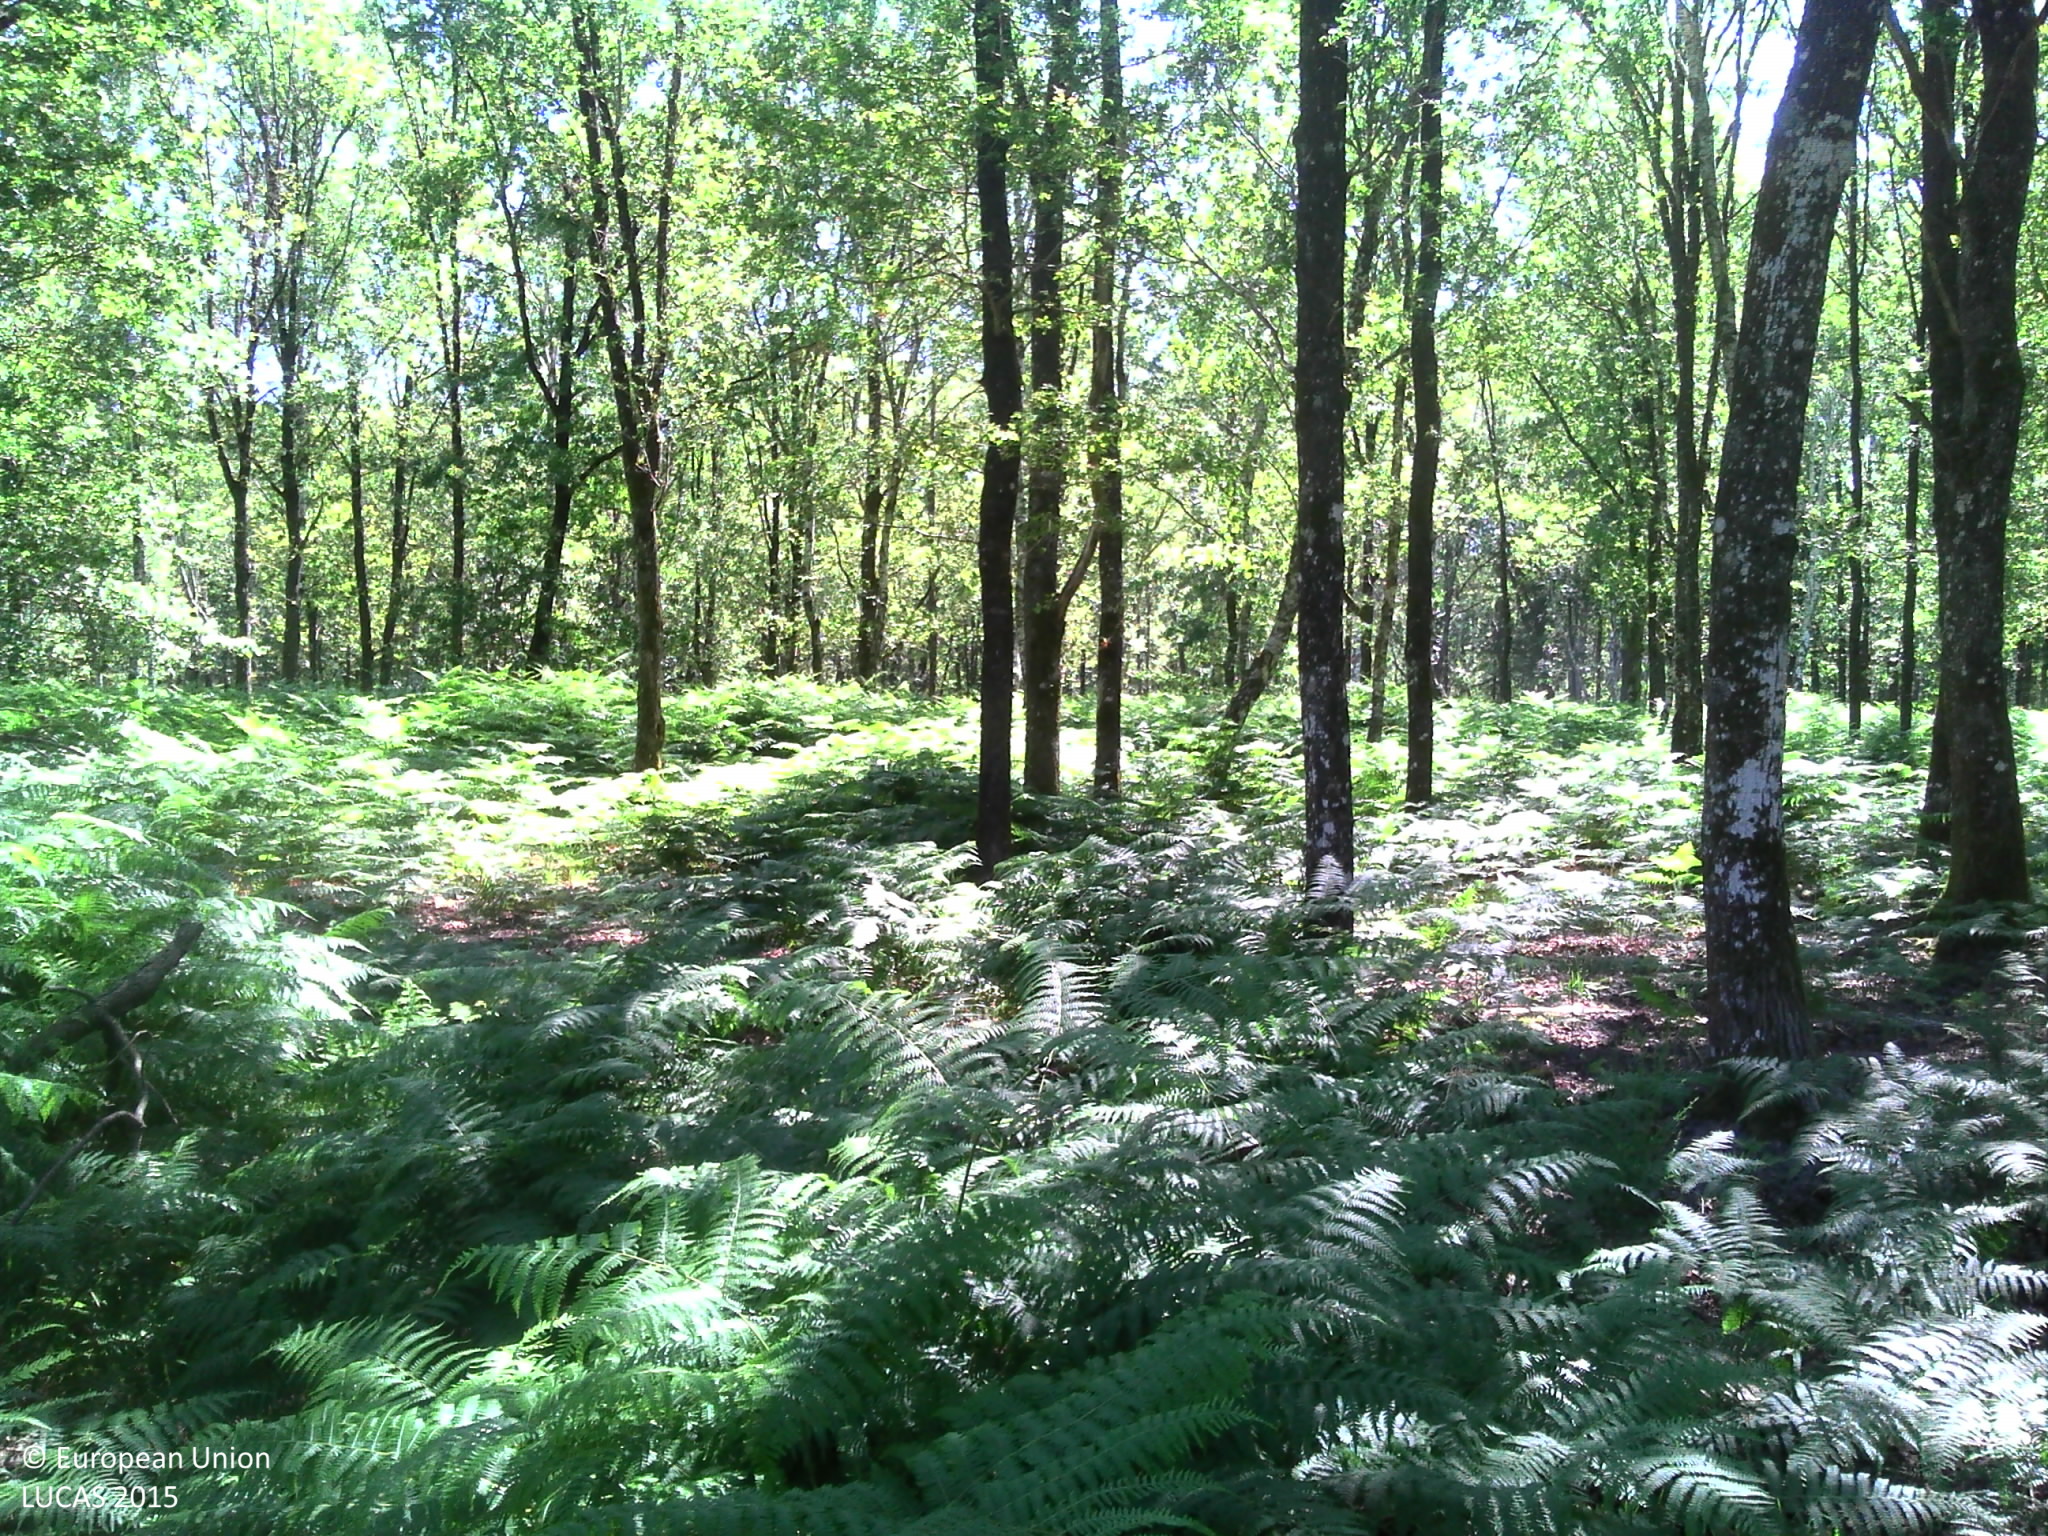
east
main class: Woodland
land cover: Broadleaved woodland
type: mesophytic deciduous forest
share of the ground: > 75 %
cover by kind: broadleaved forest trees 70 %, herbaceous plants 20 %, shrubs 5 %, lichens and mosses 5 %
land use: Forestry
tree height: > 5 m
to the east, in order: Broadleaved woodland; Tracks; Broadleaved woodland; Tracks; Fences; Broadleaved woodland
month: June
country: FR
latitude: 47.3621
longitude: 0.3251
